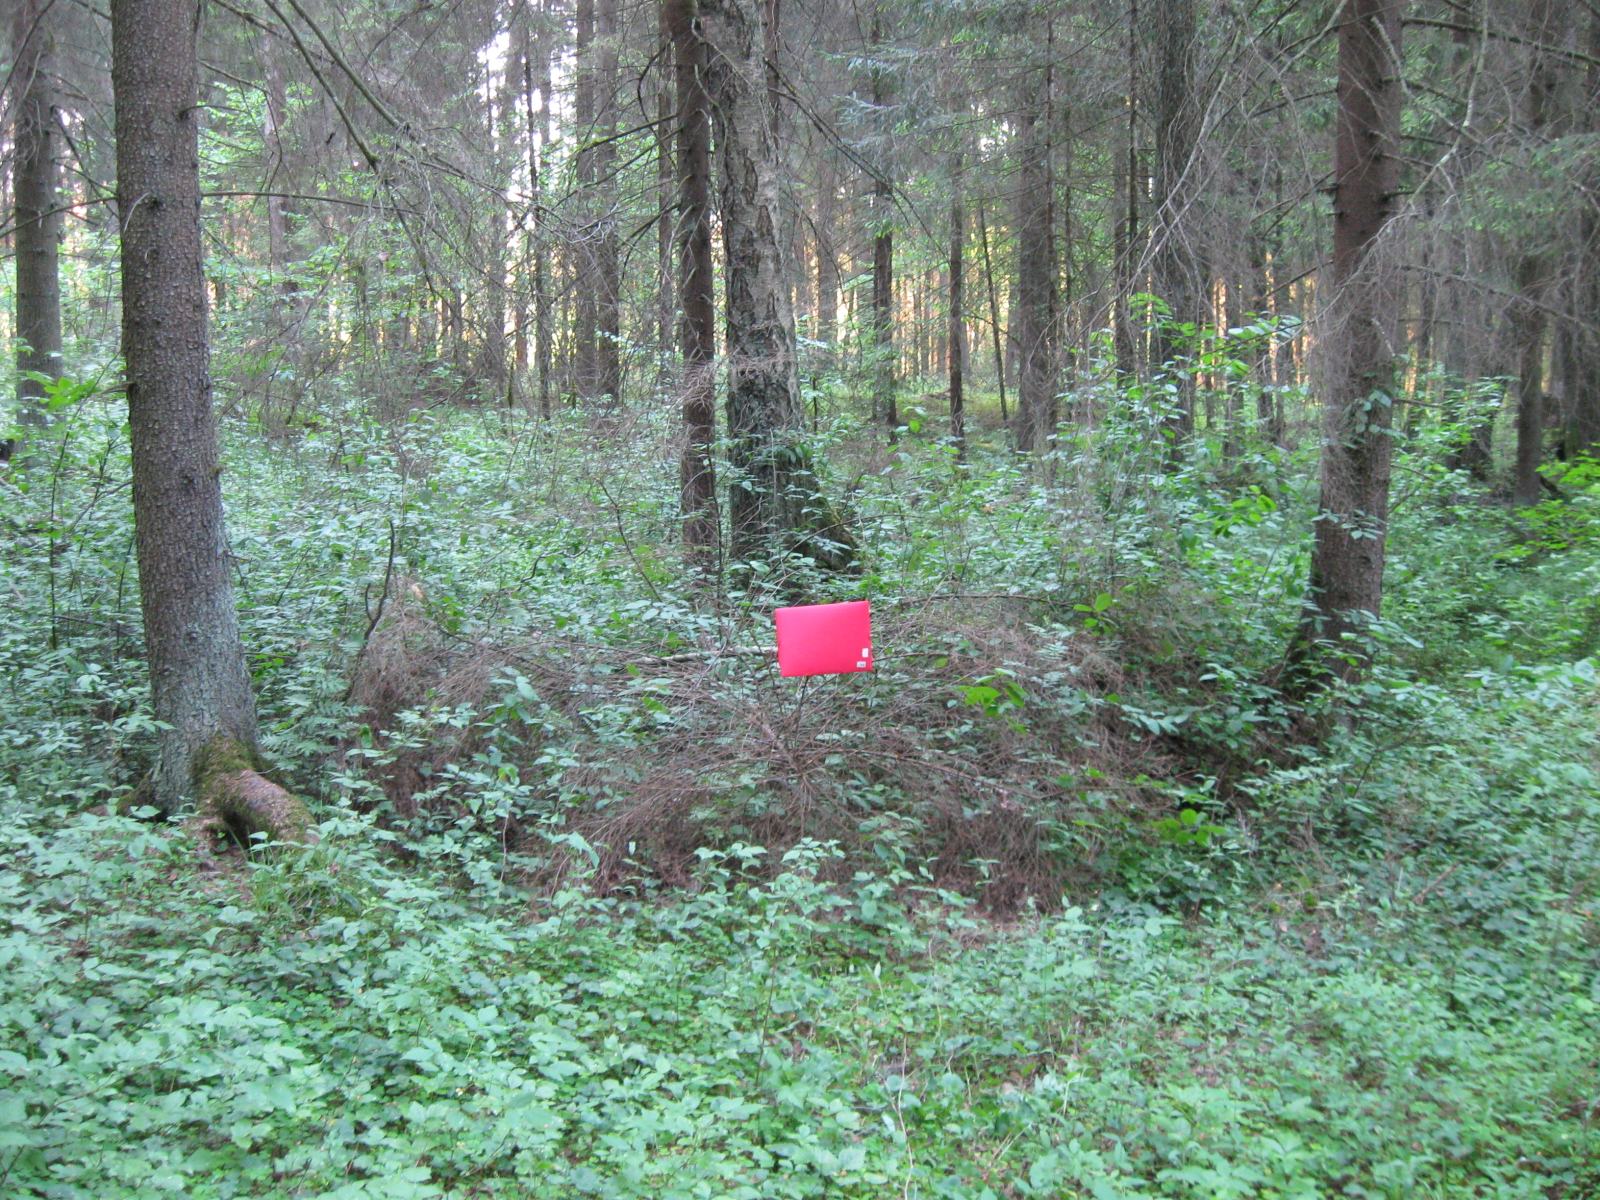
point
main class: Woodland
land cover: Spruce dominated mixed woodland
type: hemiboreal forest and nemoral coniferous forest and mixed broadleaved-coniferous forest
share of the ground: > 75 %
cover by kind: coniferous forest trees 70 %, broadleaved forest trees 30 %
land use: Forestry
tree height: > 5 m
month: June
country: LT
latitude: 54.1518
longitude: 23.6984
